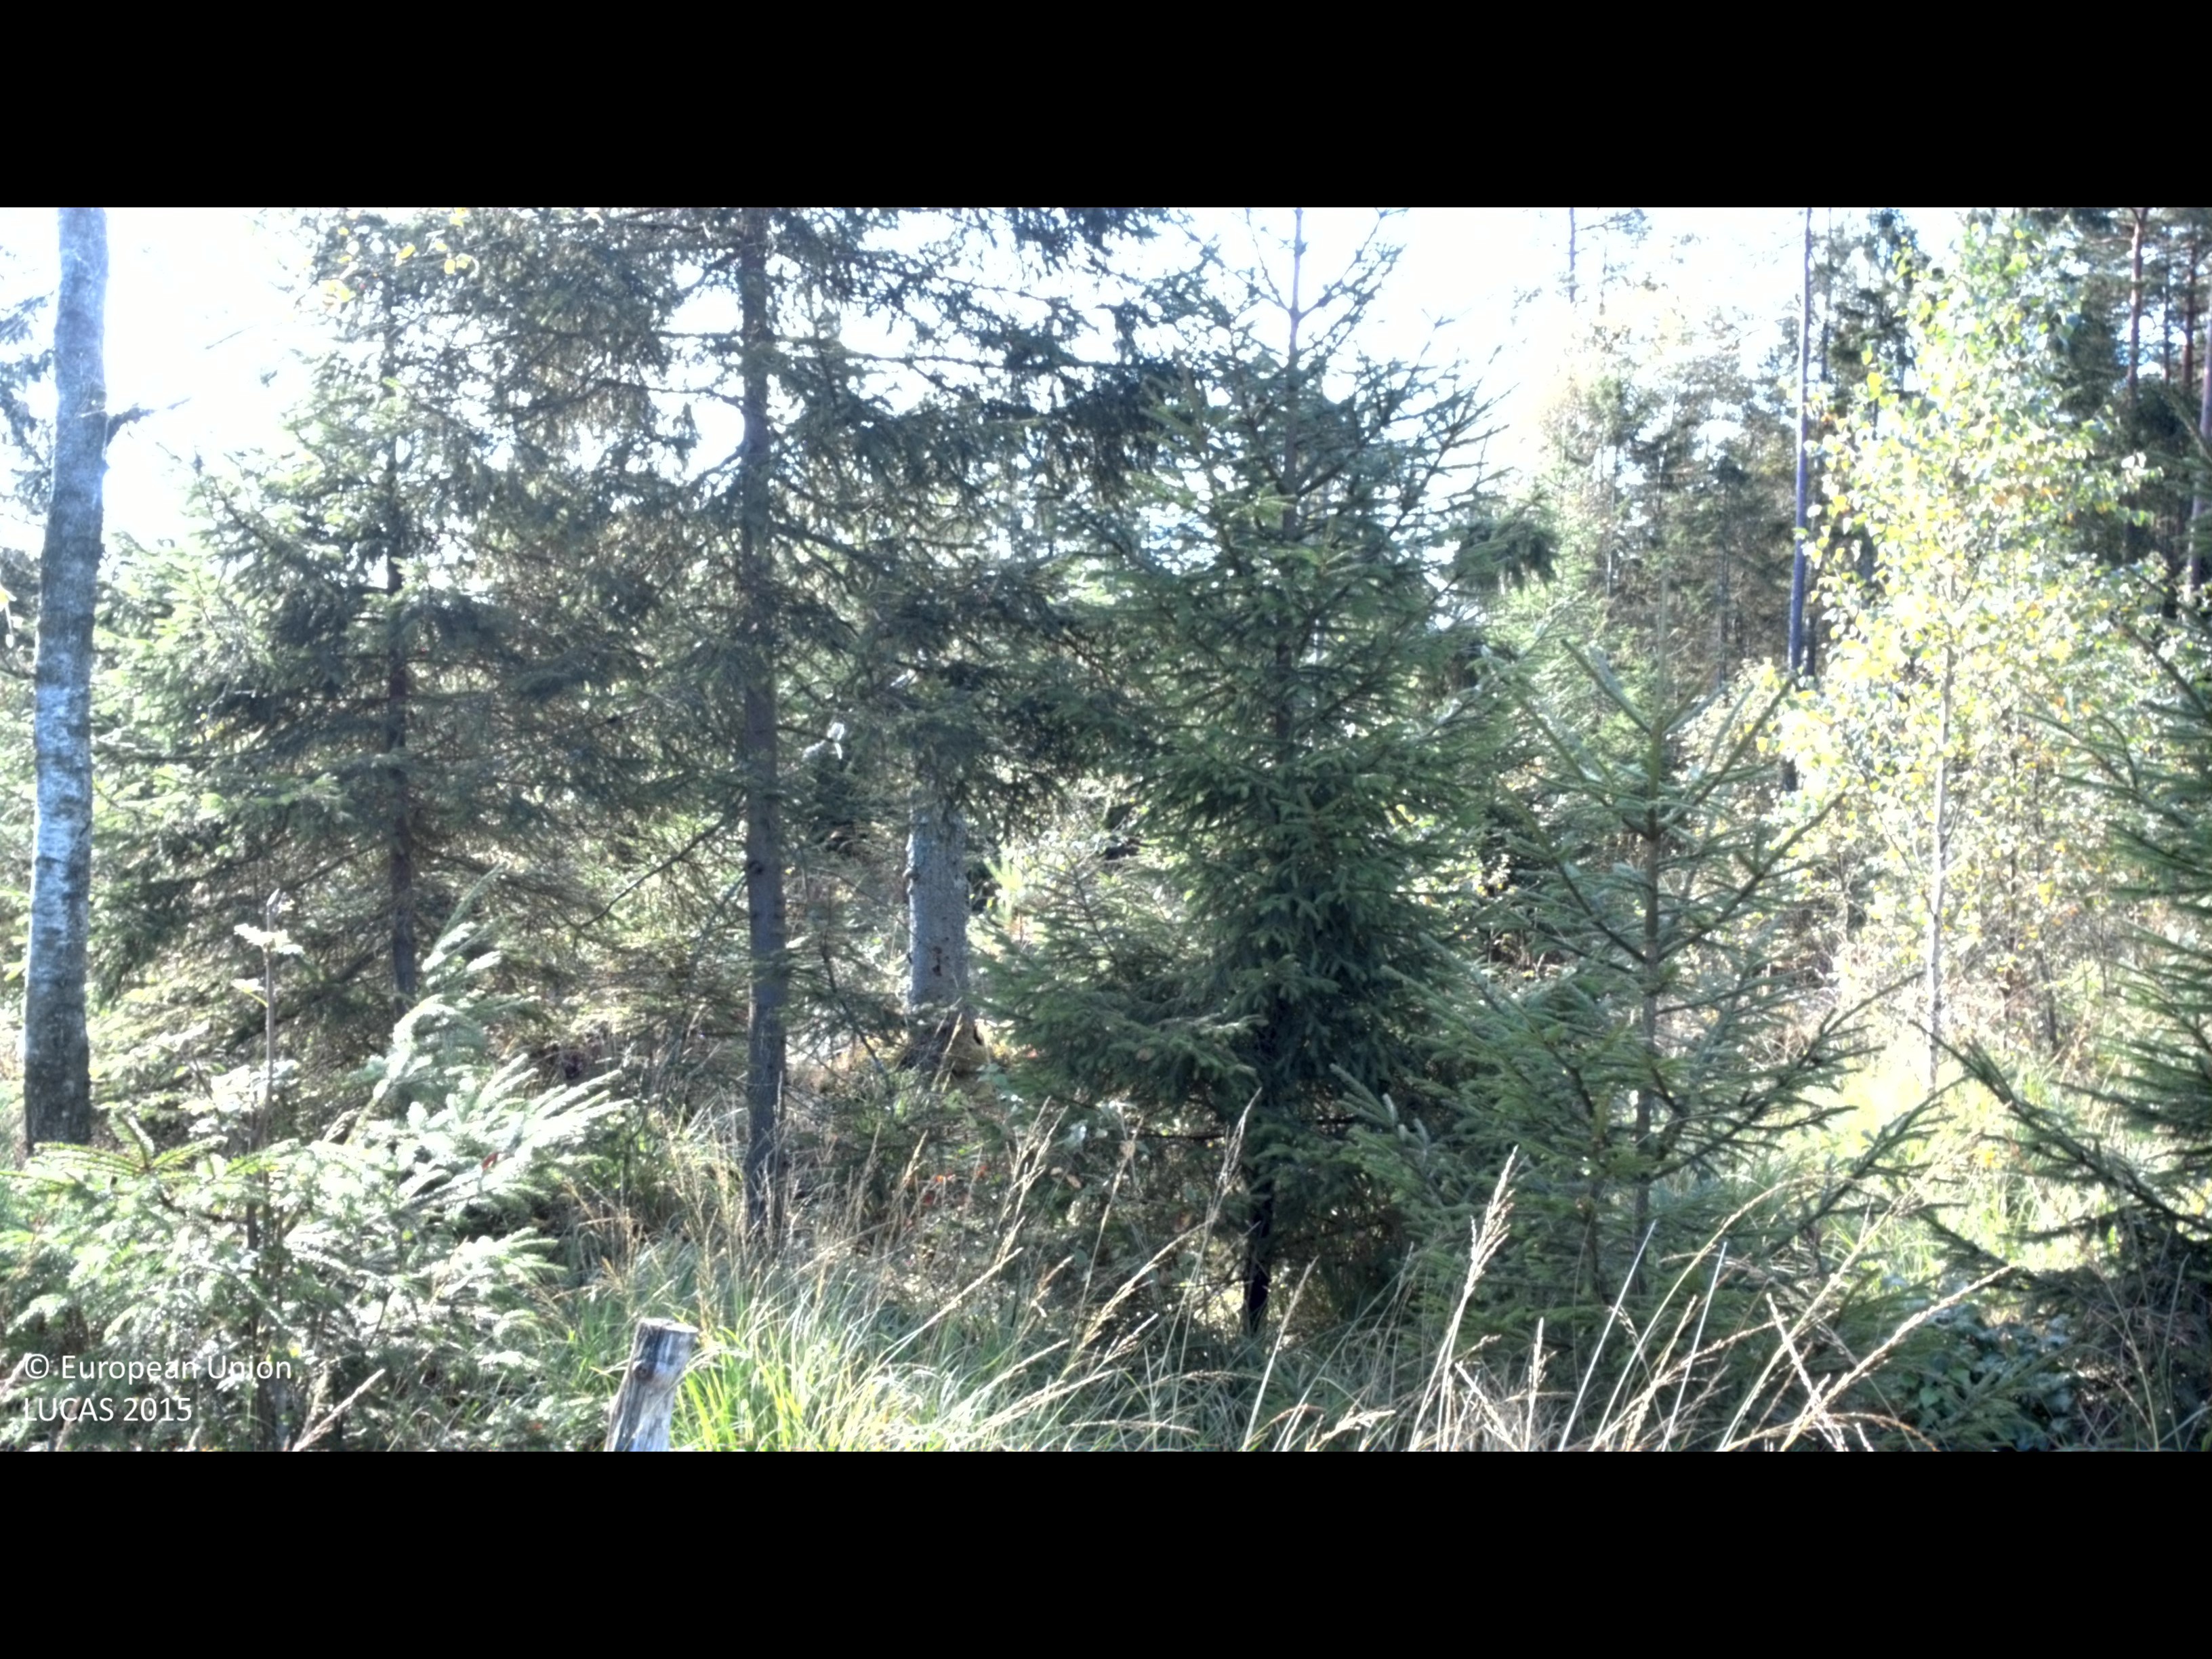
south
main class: Woodland
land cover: Spruce dominated mixed woodland
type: boreal forest
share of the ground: 50 - 75 %
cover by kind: coniferous forest trees 35 %, broadleaved forest trees 25 %, shrubs 20 %, herbaceous plants 20 %
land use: Forestry
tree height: < 5 m
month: September
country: SE
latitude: 56.8514
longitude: 13.1285
